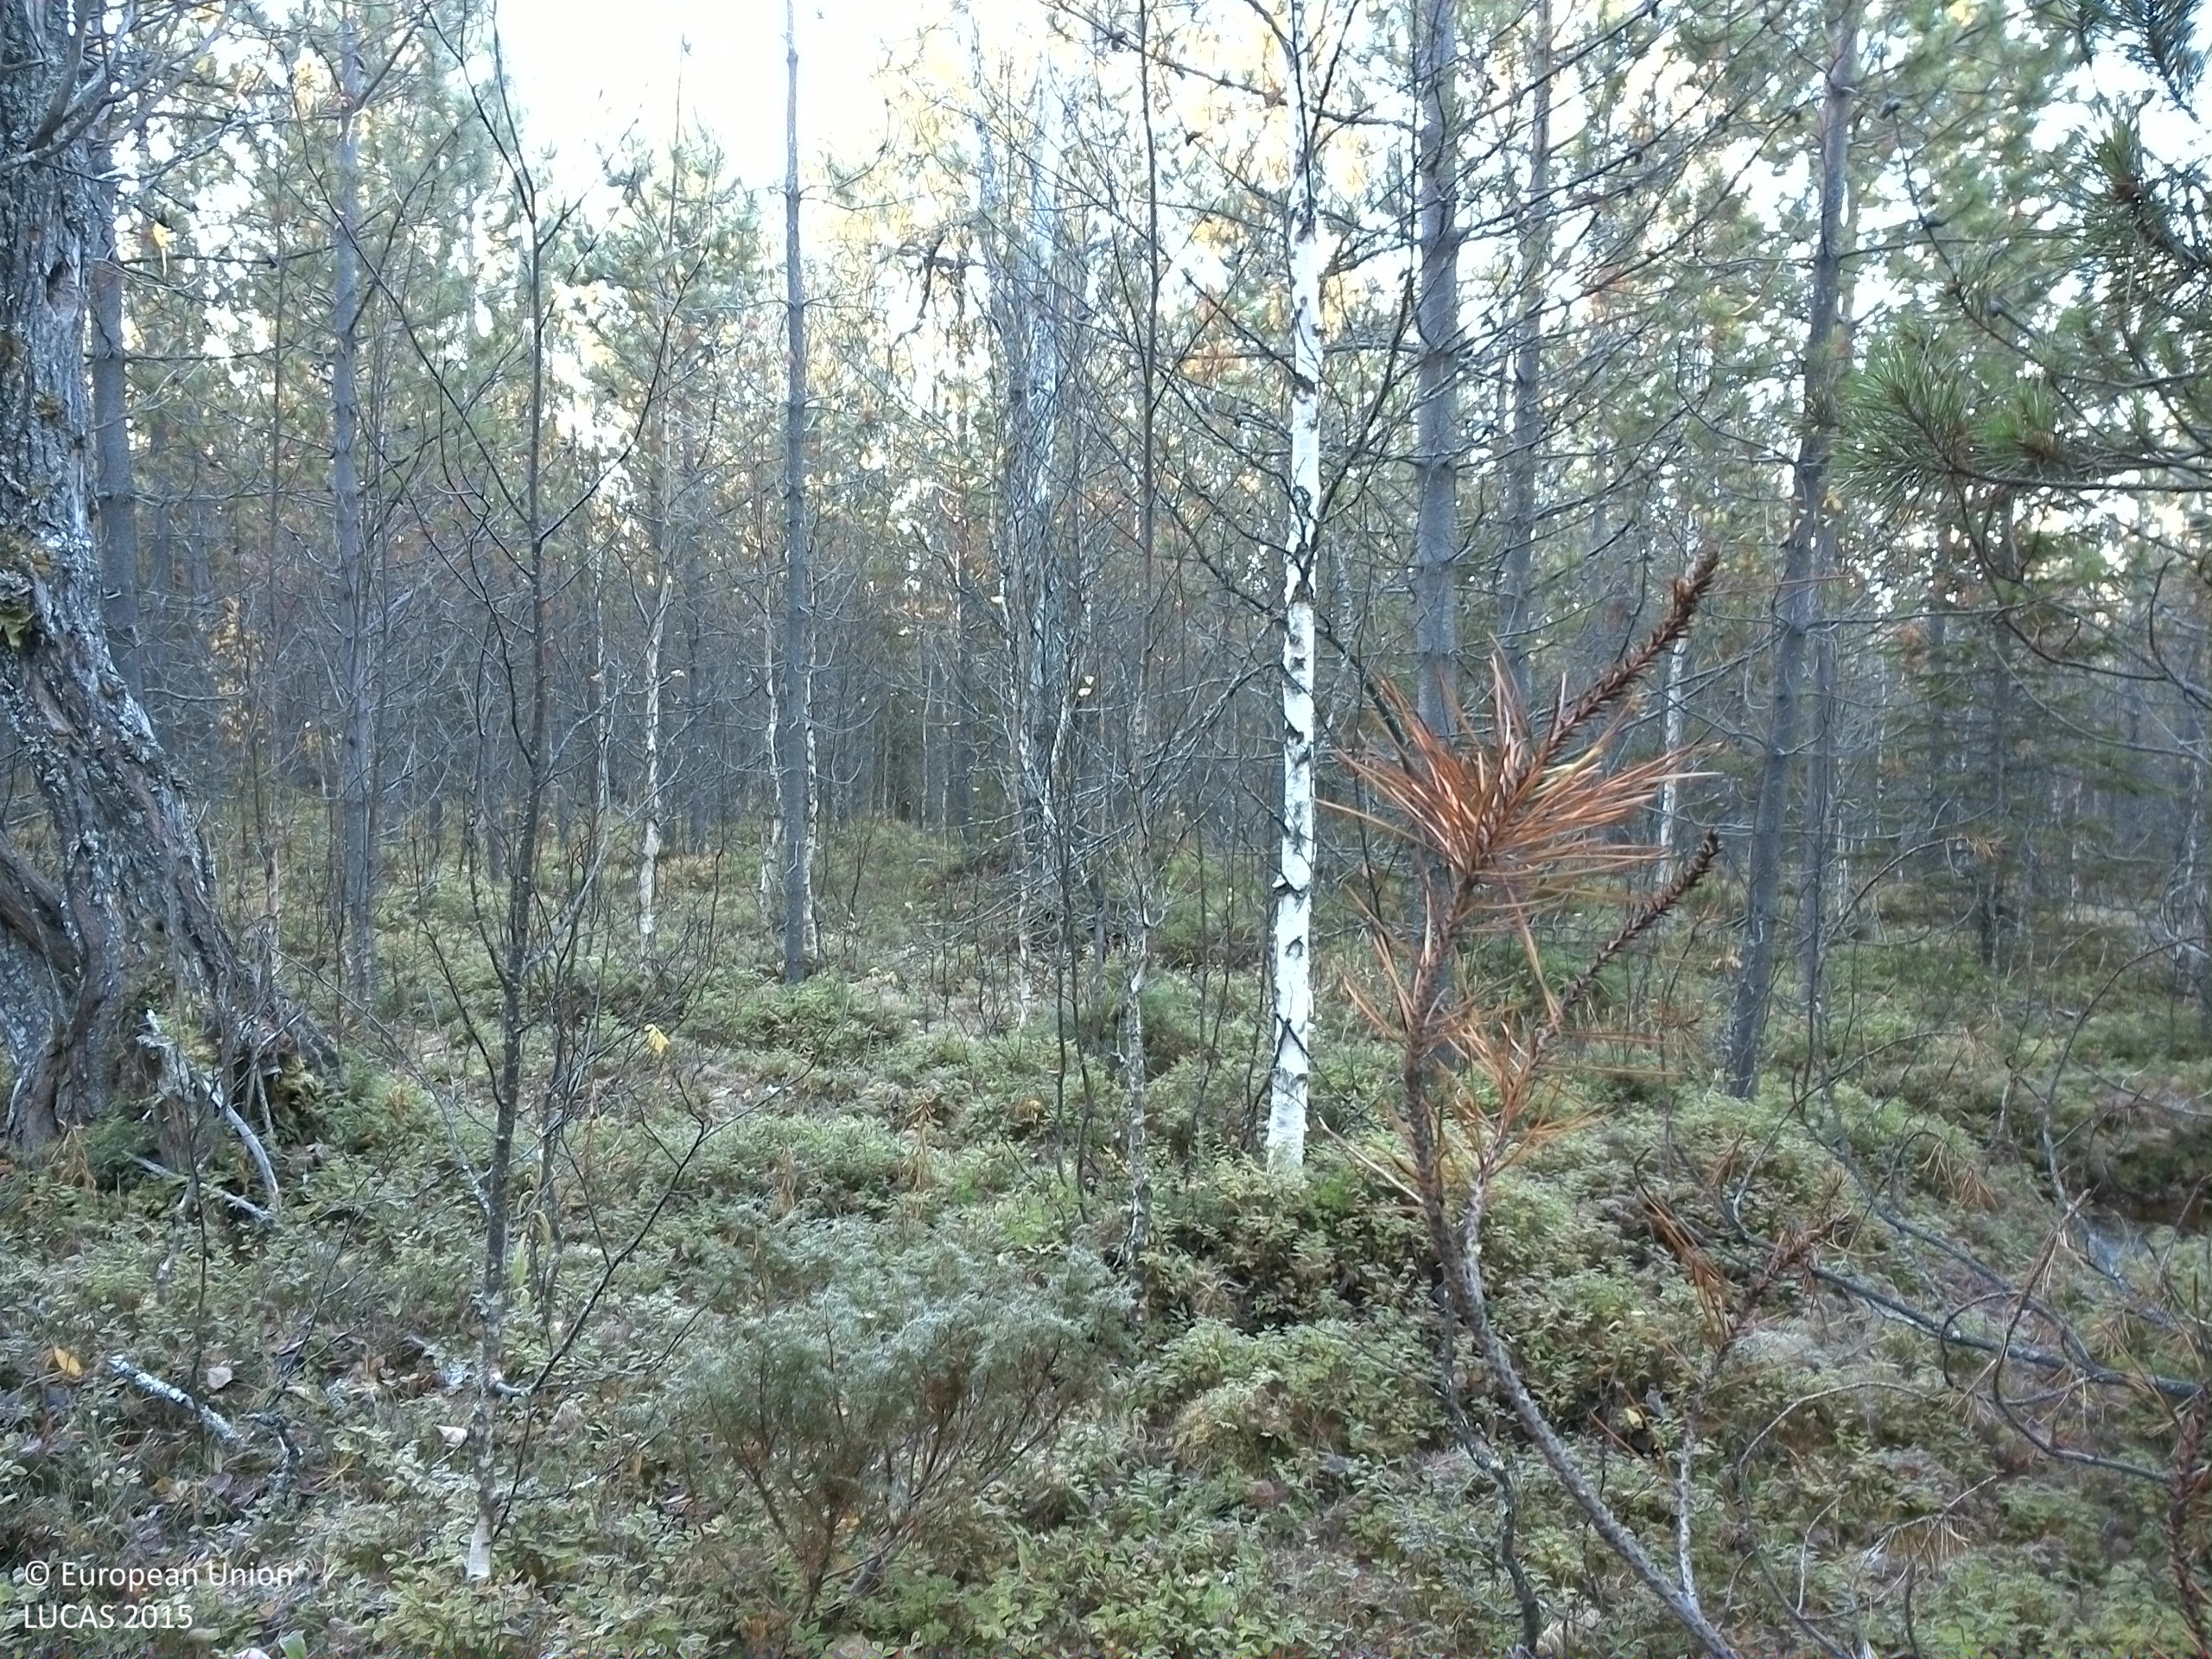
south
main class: Woodland
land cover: Pine dominated mixed woodland
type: exotic forest
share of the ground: 50 - 75 %
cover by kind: coniferous forest trees 40 %, shrubs 35 %, broadleaved forest trees 15 %, lichens and mosses 10 %
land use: Forestry
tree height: > 5 m
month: October
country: SE
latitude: 64.5549
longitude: 15.5394
